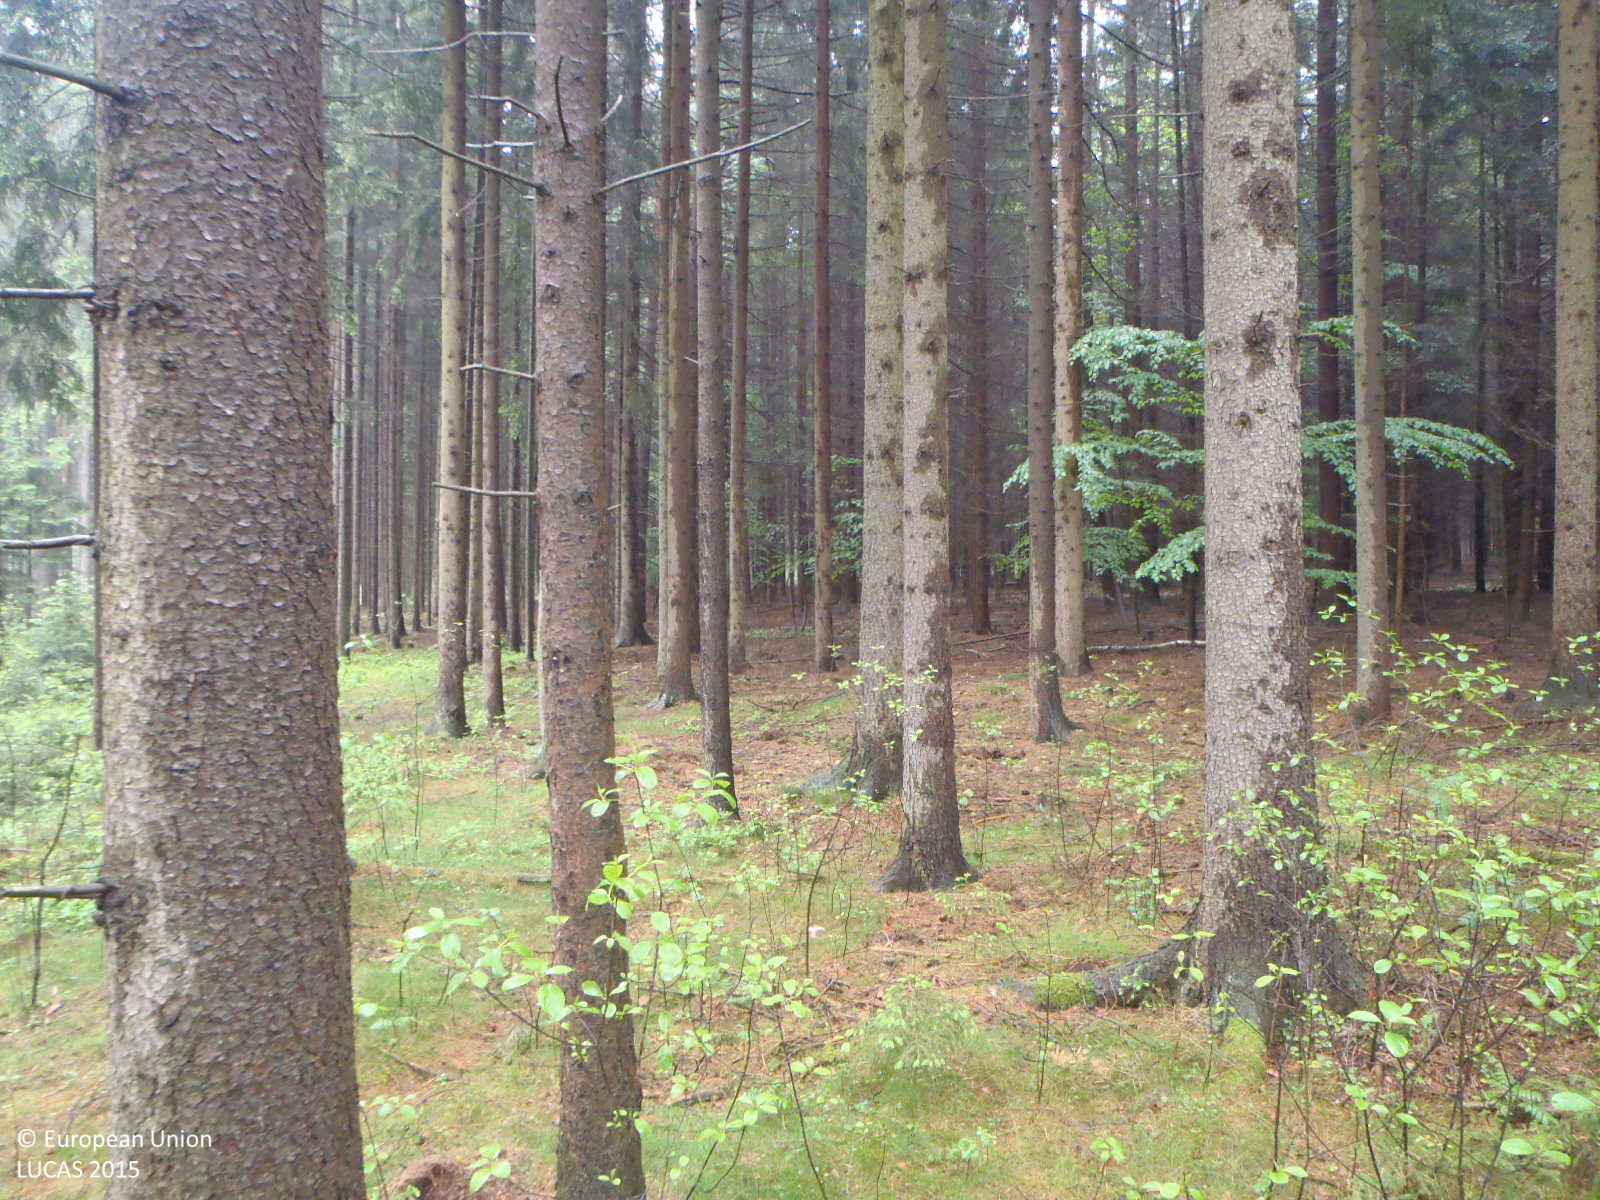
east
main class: Woodland
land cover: Other coniferous woodland
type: hemiboreal forest and nemoral coniferous forest and mixed broadleaved-coniferous forest
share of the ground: > 75 %
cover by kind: coniferous forest trees 75 %, broadleaved forest trees 10 %, shrubs 5 %, herbaceous plants 5 %, lichens and mosses 5 %
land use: Forestry
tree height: > 5 m
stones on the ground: 10 - 25 %
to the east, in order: Other coniferous woodland; Other mixed woodland; Spruce dominated coniferous woodland; Ditches and canals; Spruce dominated coniferous woodland
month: May
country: CZ
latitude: 48.7835
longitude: 14.4240
